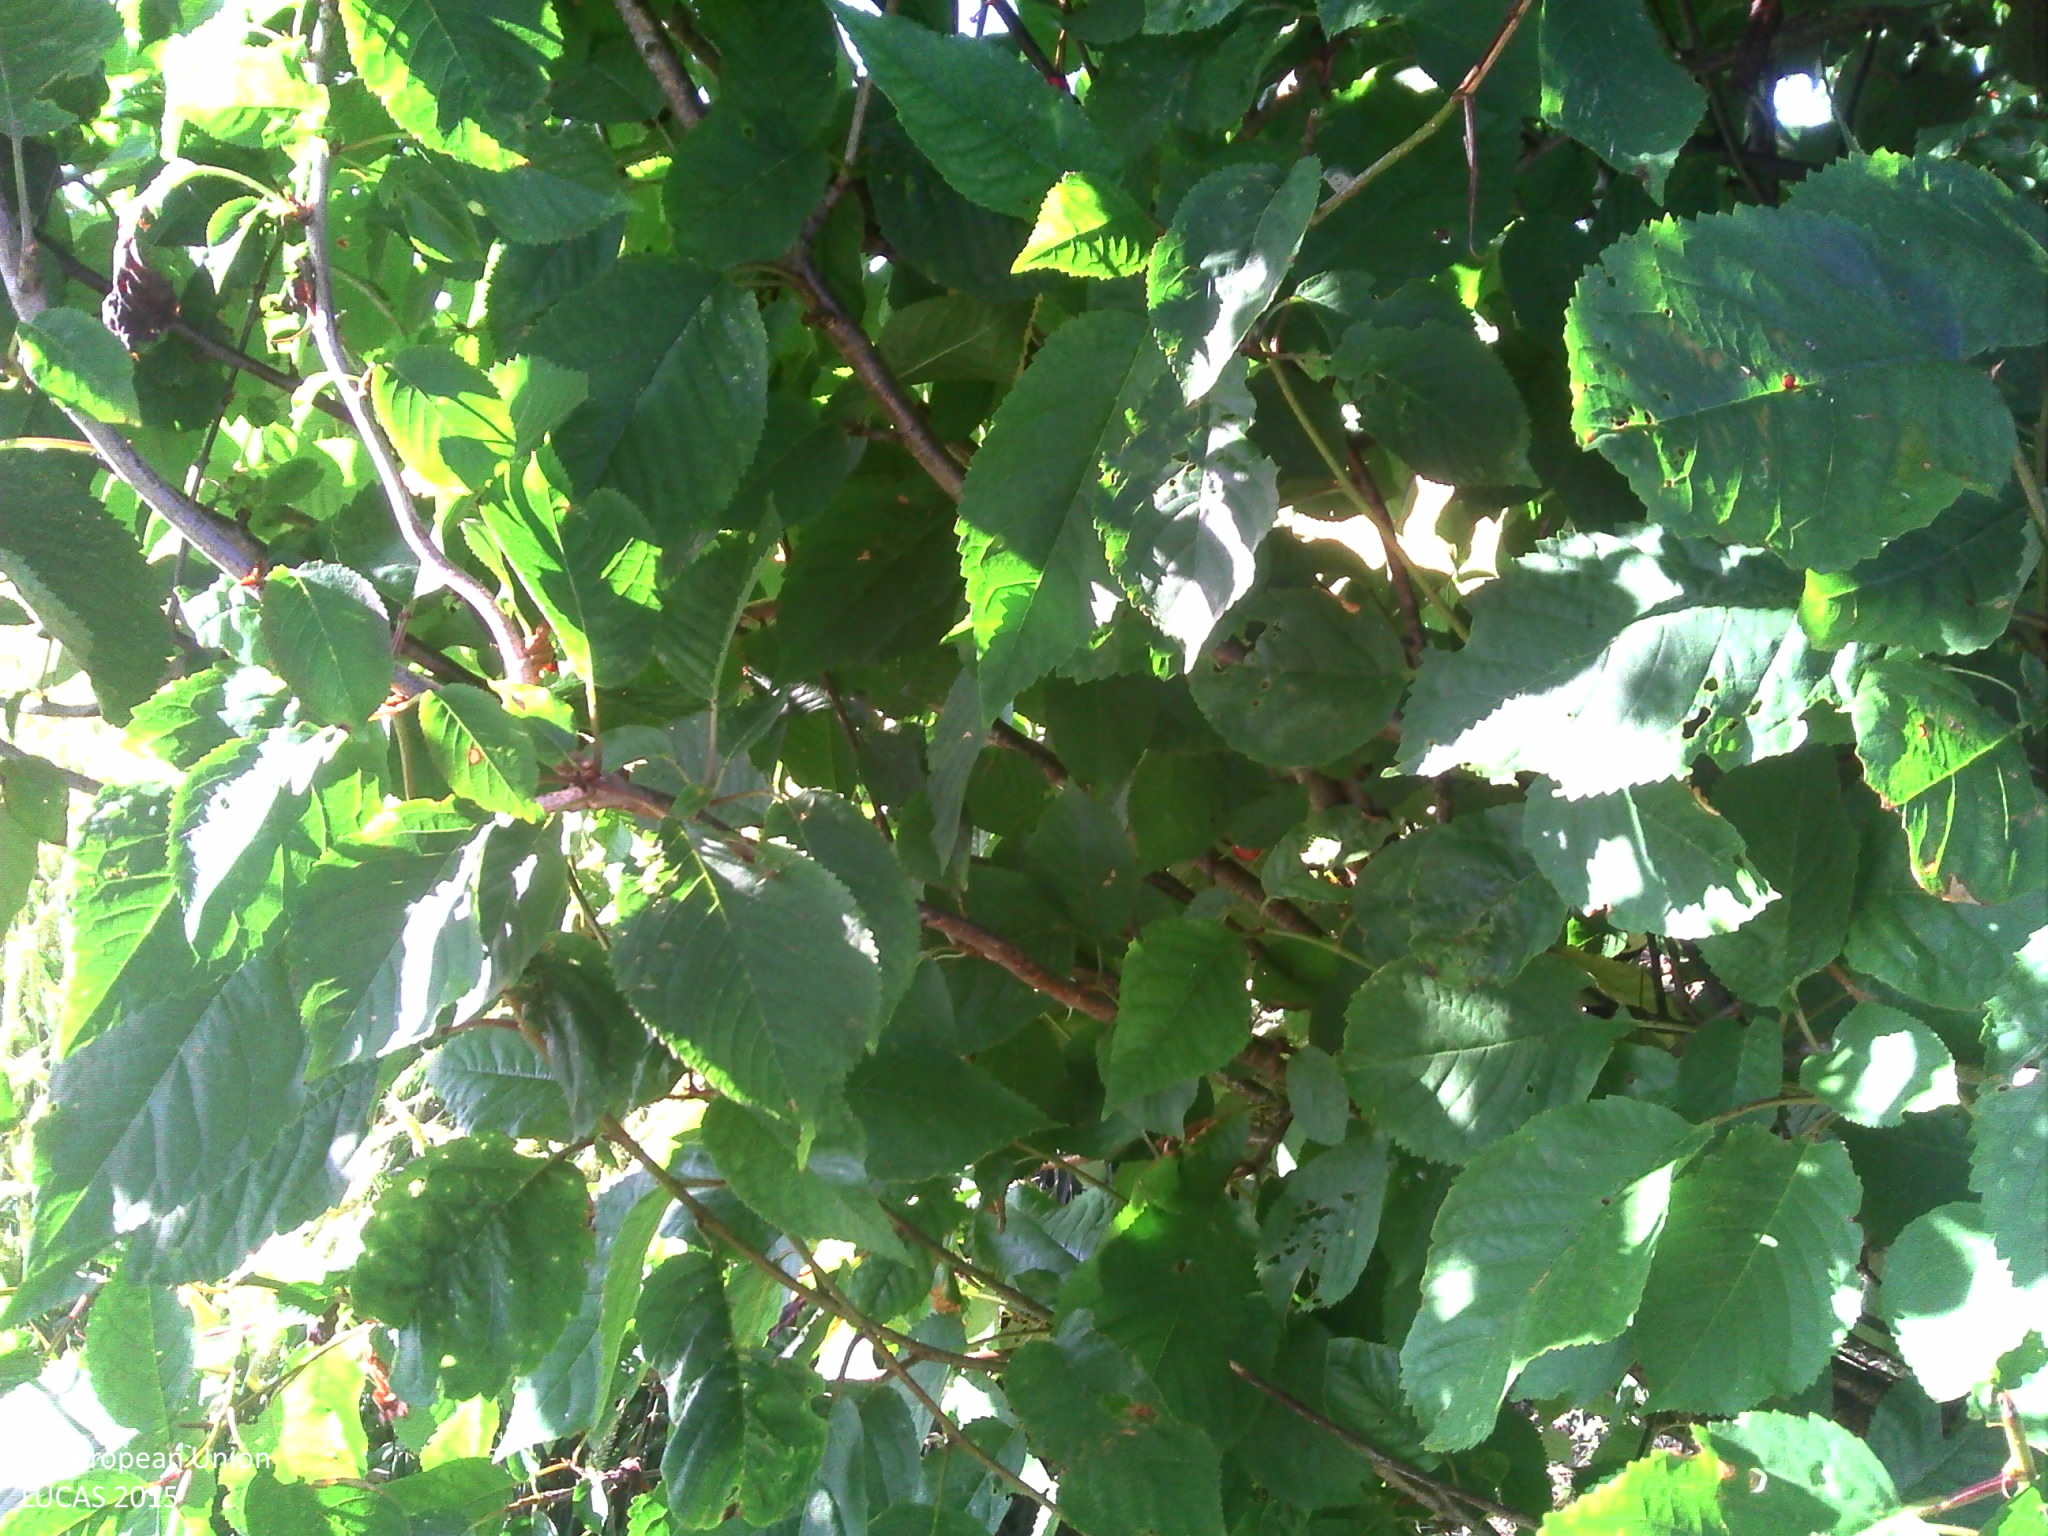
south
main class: Grassland
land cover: Grassland without tree/shrub cover
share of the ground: > 75 %
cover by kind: herbaceous plants 100 %
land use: Agriculture (excluding fallow land and kitchen gardens)
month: July
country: FR
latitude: 49.9528
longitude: 1.6897
